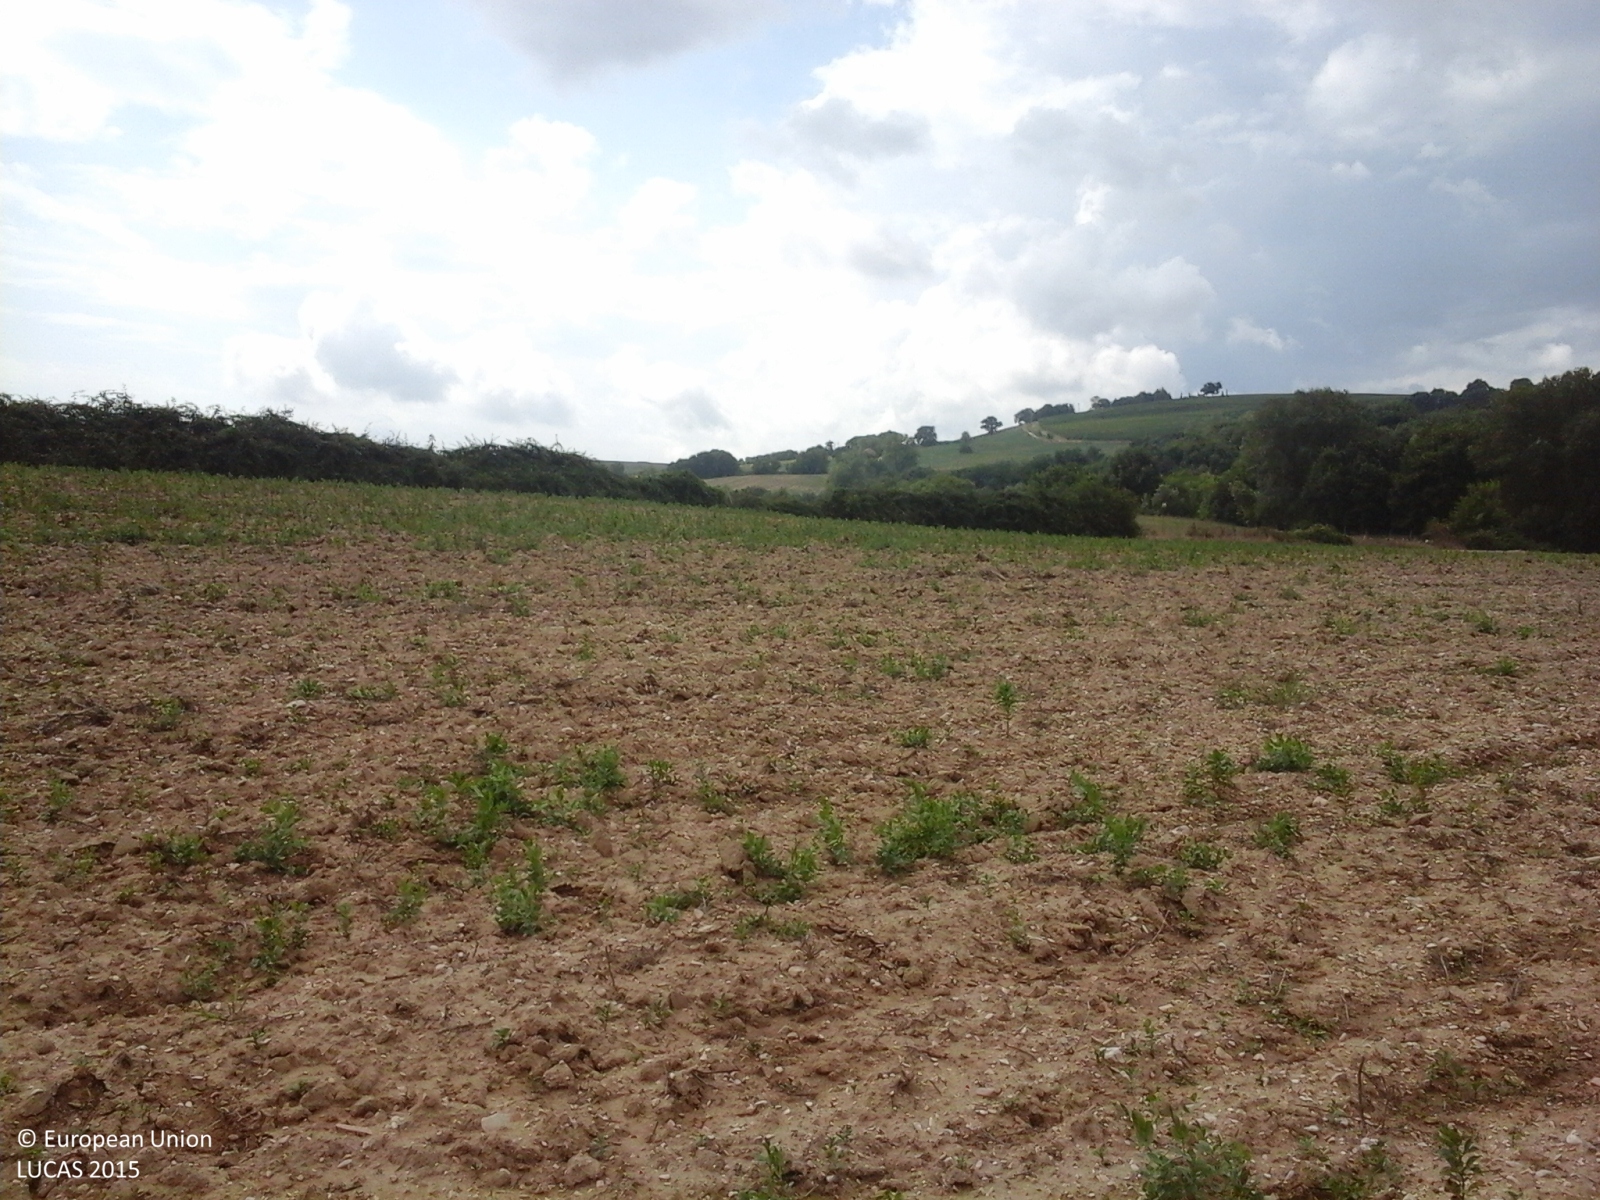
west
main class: Cropland
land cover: Dry pulses
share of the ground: < 10 %
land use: Agriculture (excluding fallow land and kitchen gardens)
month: August
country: IT
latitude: 43.4505
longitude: 13.2665
